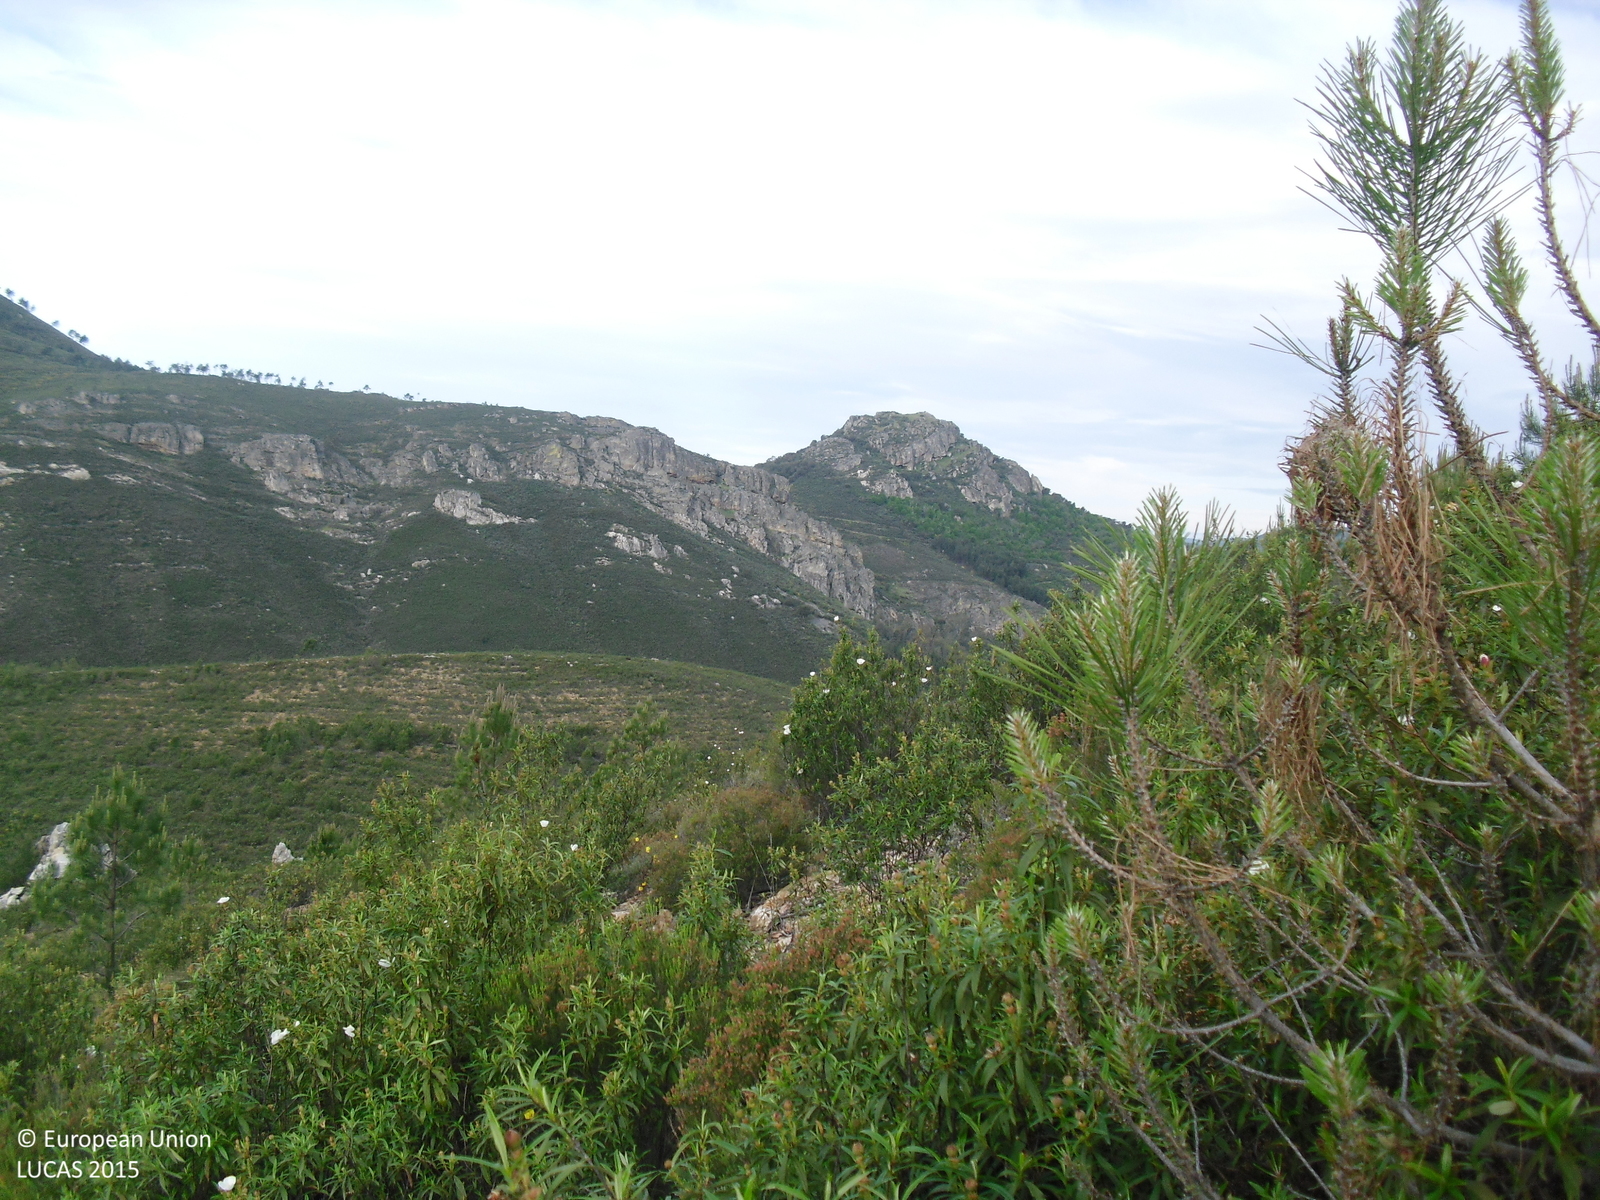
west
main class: Shrubland
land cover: Shrubland with sparse tree cover
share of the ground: > 75 %
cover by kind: shrubs 80 %, unconsolidated bare surface 15 %, broadleaved forest trees 5 %
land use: Semi-natural and natural areas not in use
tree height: < 5 m
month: May
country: ES
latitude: 39.3806
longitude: -5.3600
